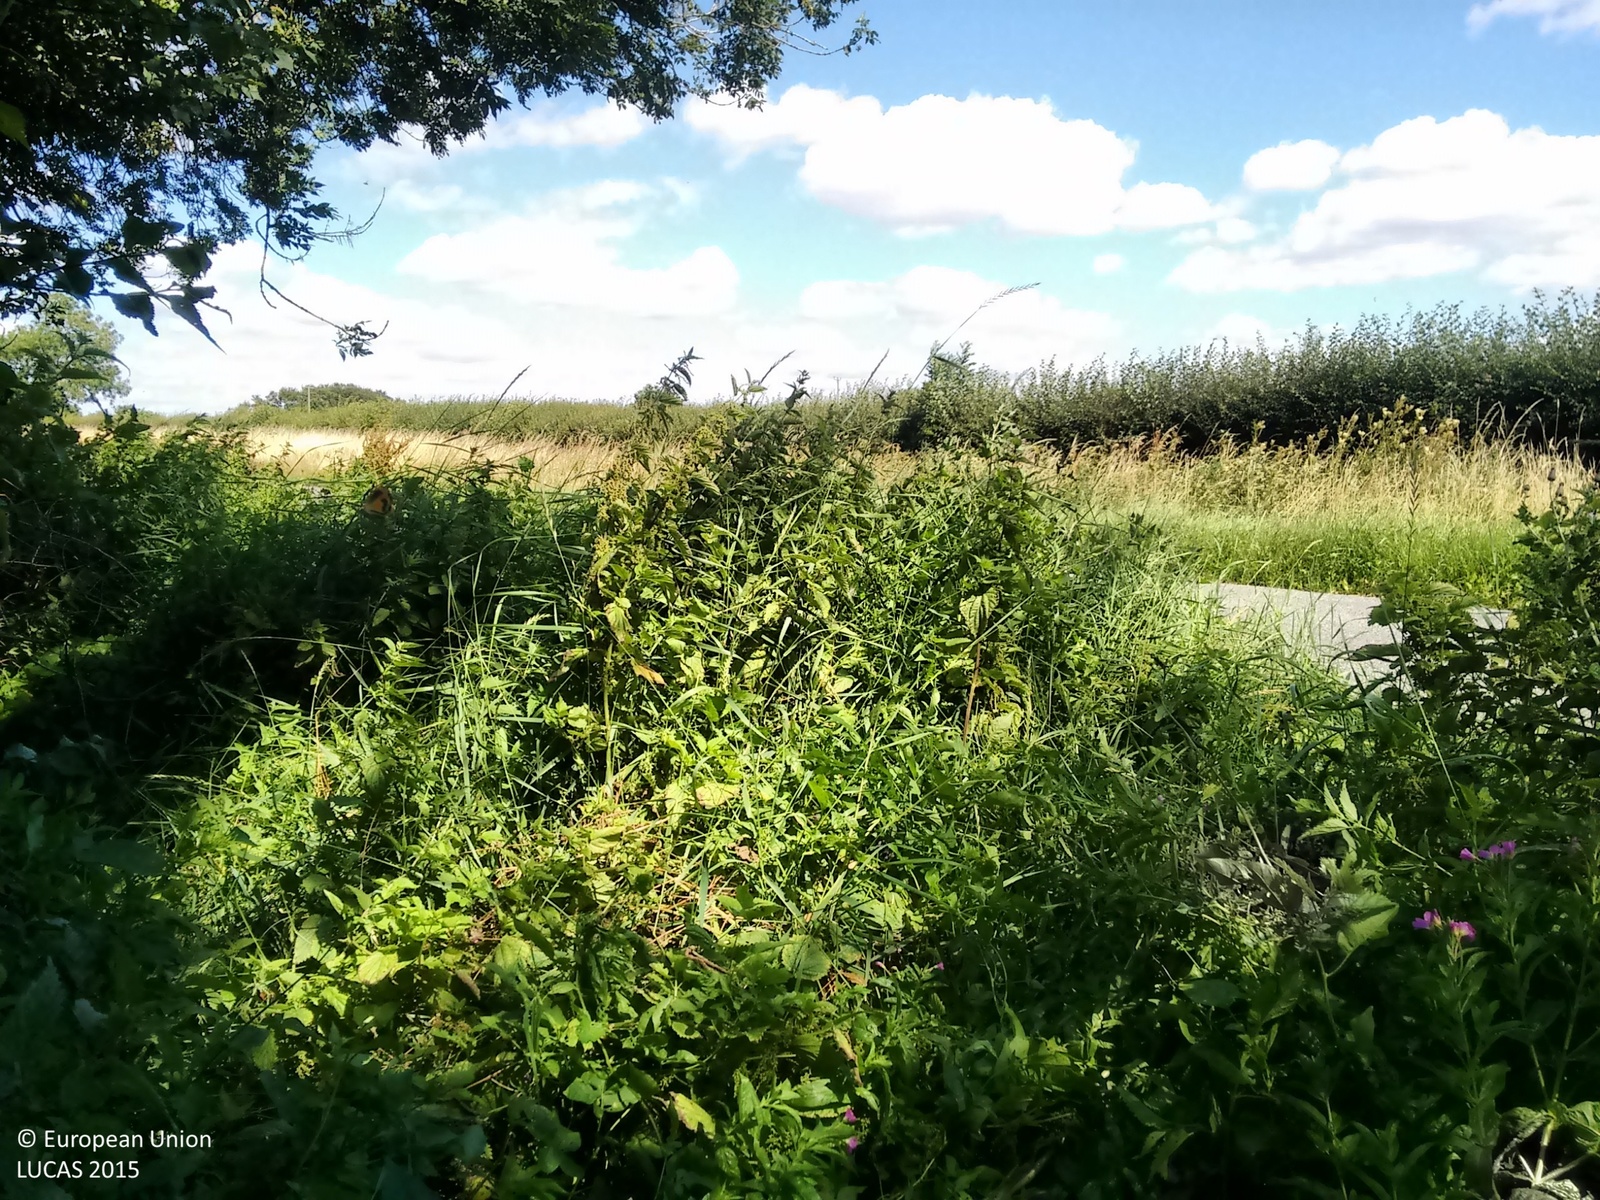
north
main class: Grassland
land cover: Grassland without tree/shrub cover
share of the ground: > 75 %
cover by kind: herbaceous plants 100 %
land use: Agriculture (excluding fallow land and kitchen gardens)
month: August
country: GB
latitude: 52.0591
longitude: 0.3888
